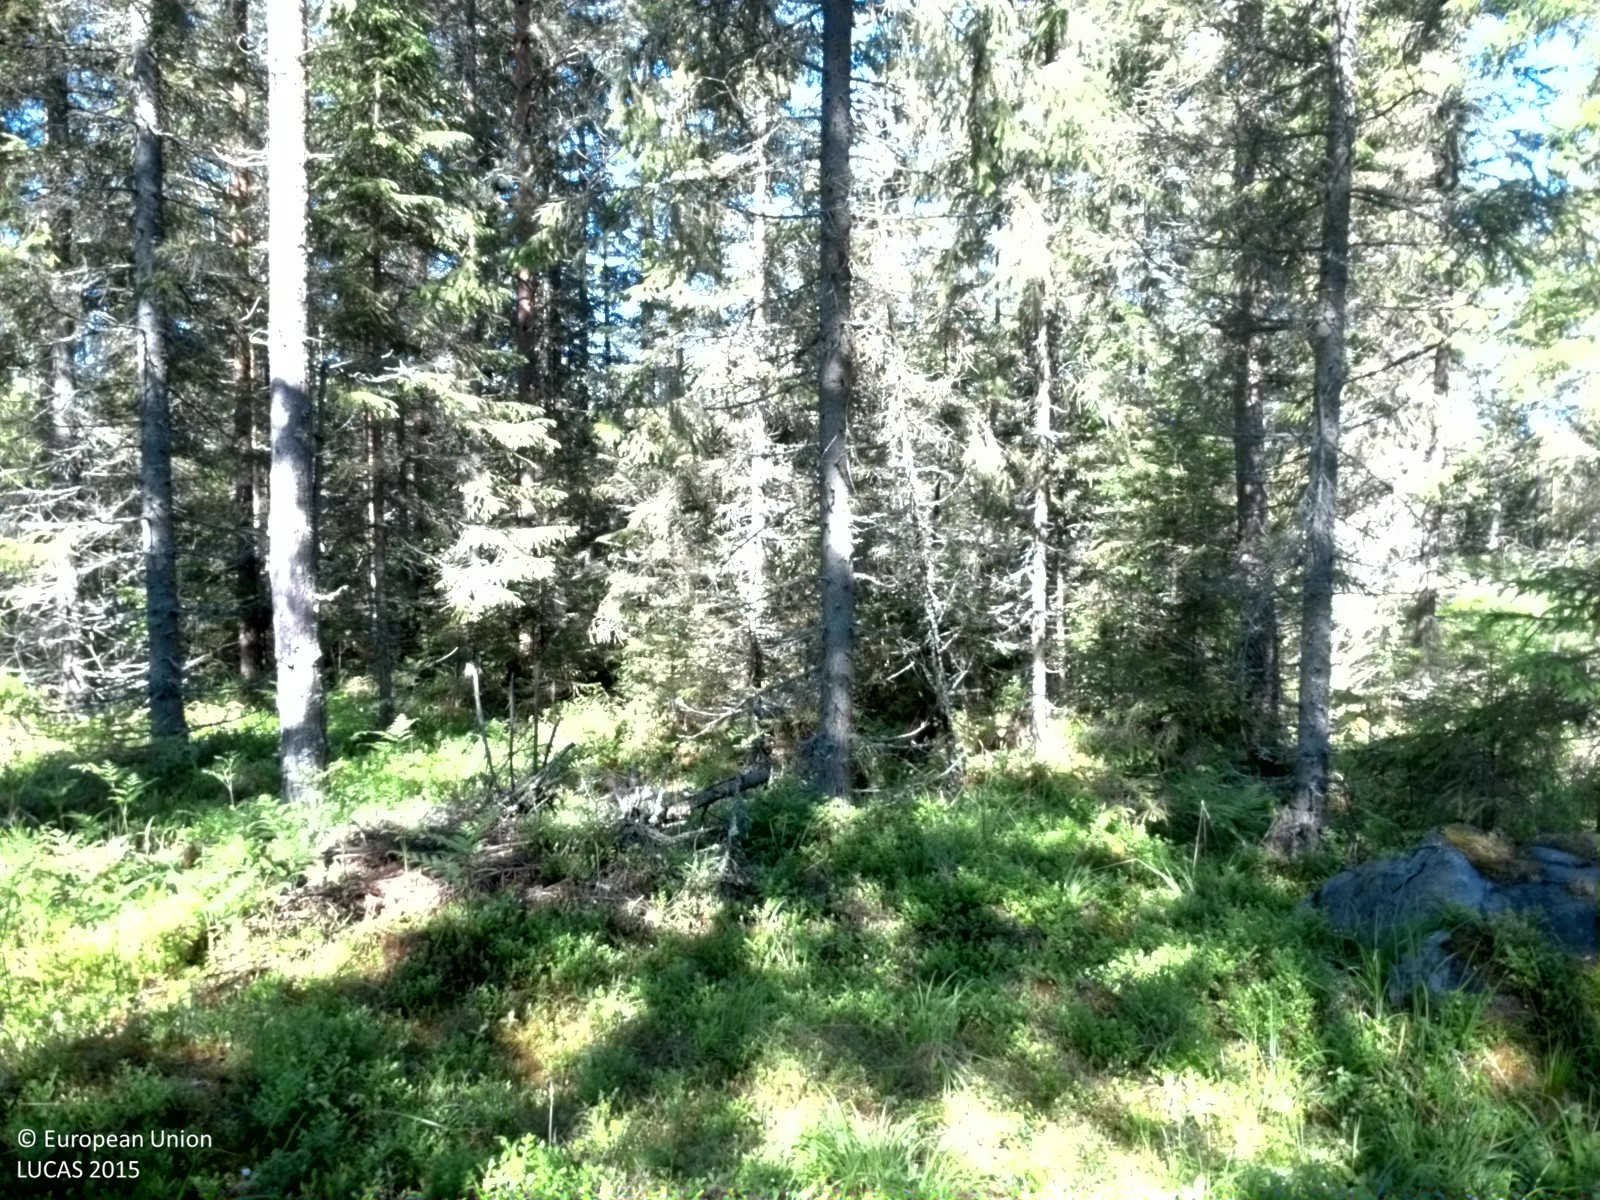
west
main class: Woodland
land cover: Other coniferous woodland
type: boreal forest
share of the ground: 50 - 75 %
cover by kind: coniferous forest trees 60 %, shrubs 15 %, herbaceous plants 10 %, lichens and mosses 10 %, consolidated bare surface 5 %
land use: Forestry
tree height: > 5 m
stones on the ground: 25 - 50 %
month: June
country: SE
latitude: 60.1341
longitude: 17.6806
